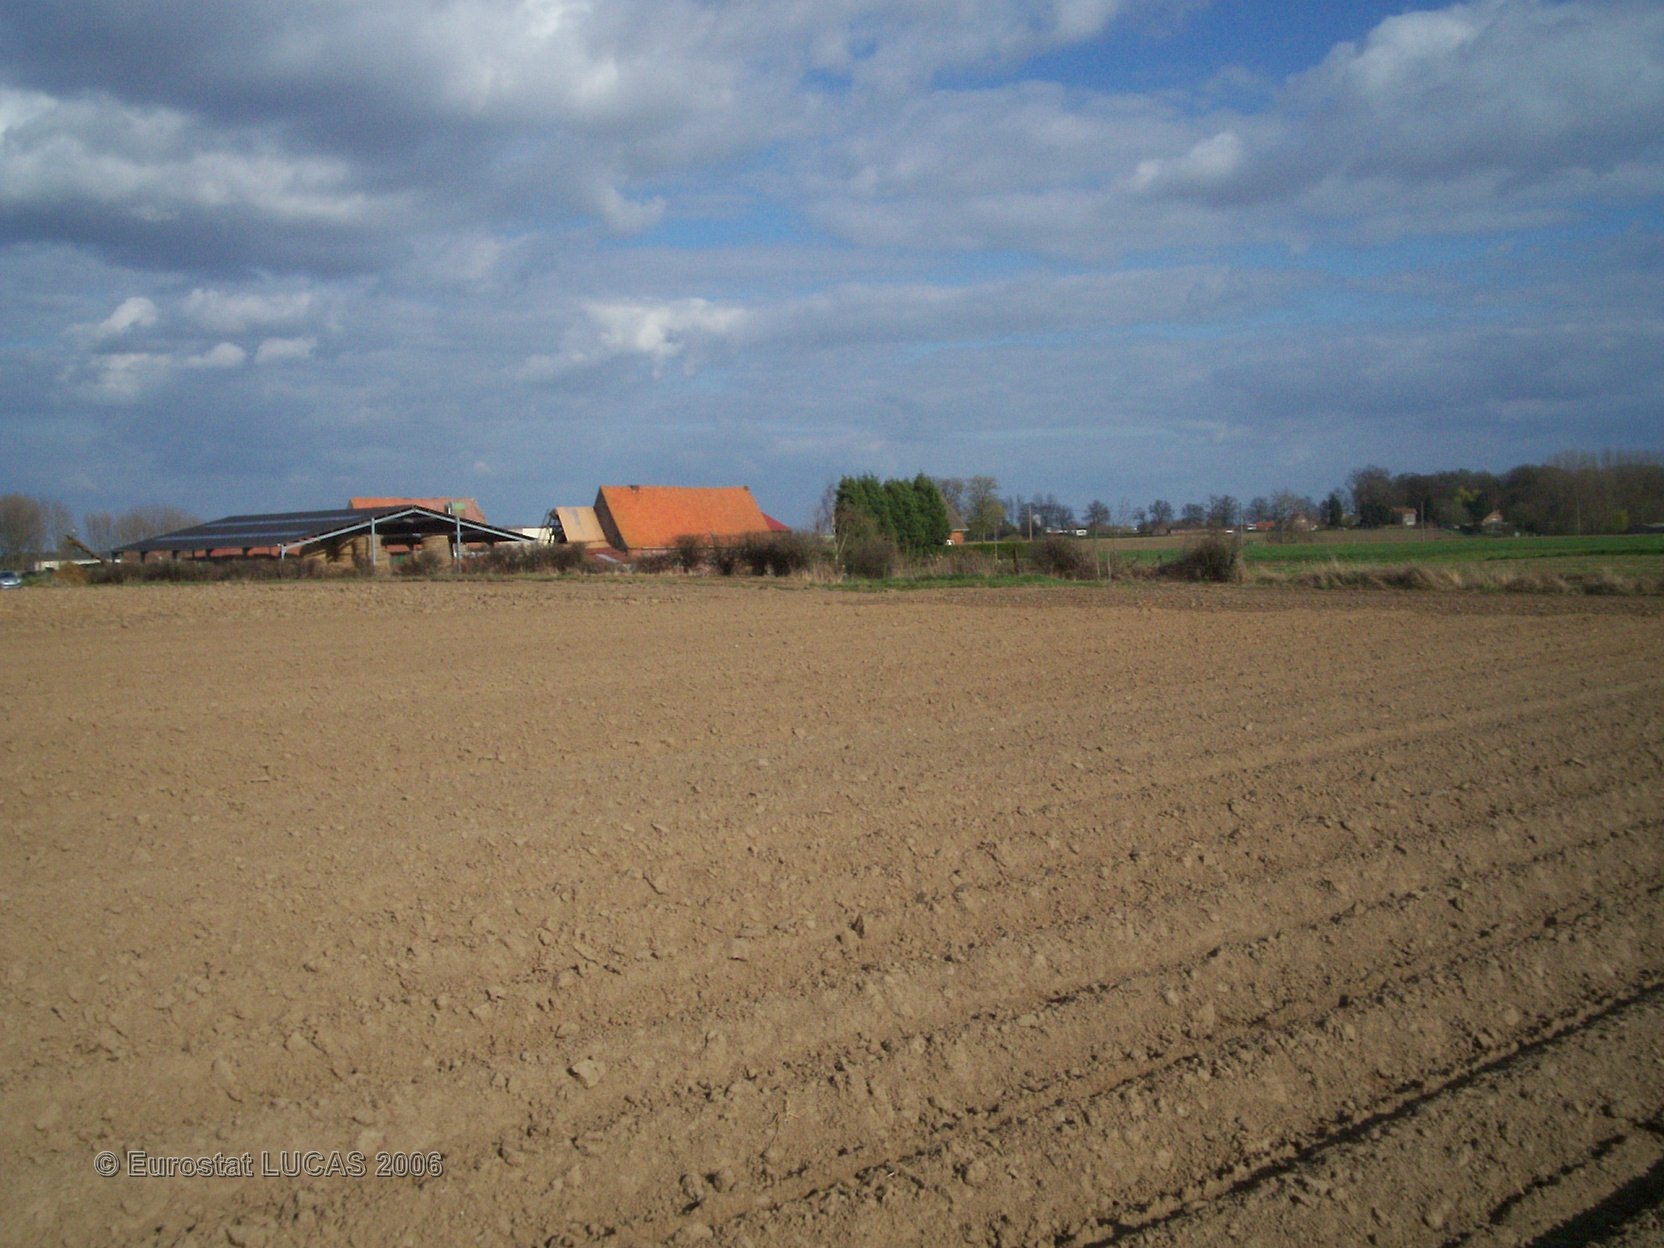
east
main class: Cropland
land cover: Potatoes
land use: Agriculture (excluding fallow land and kitchen gardens)
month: May
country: FR
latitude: 50.8920
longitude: 2.4664
